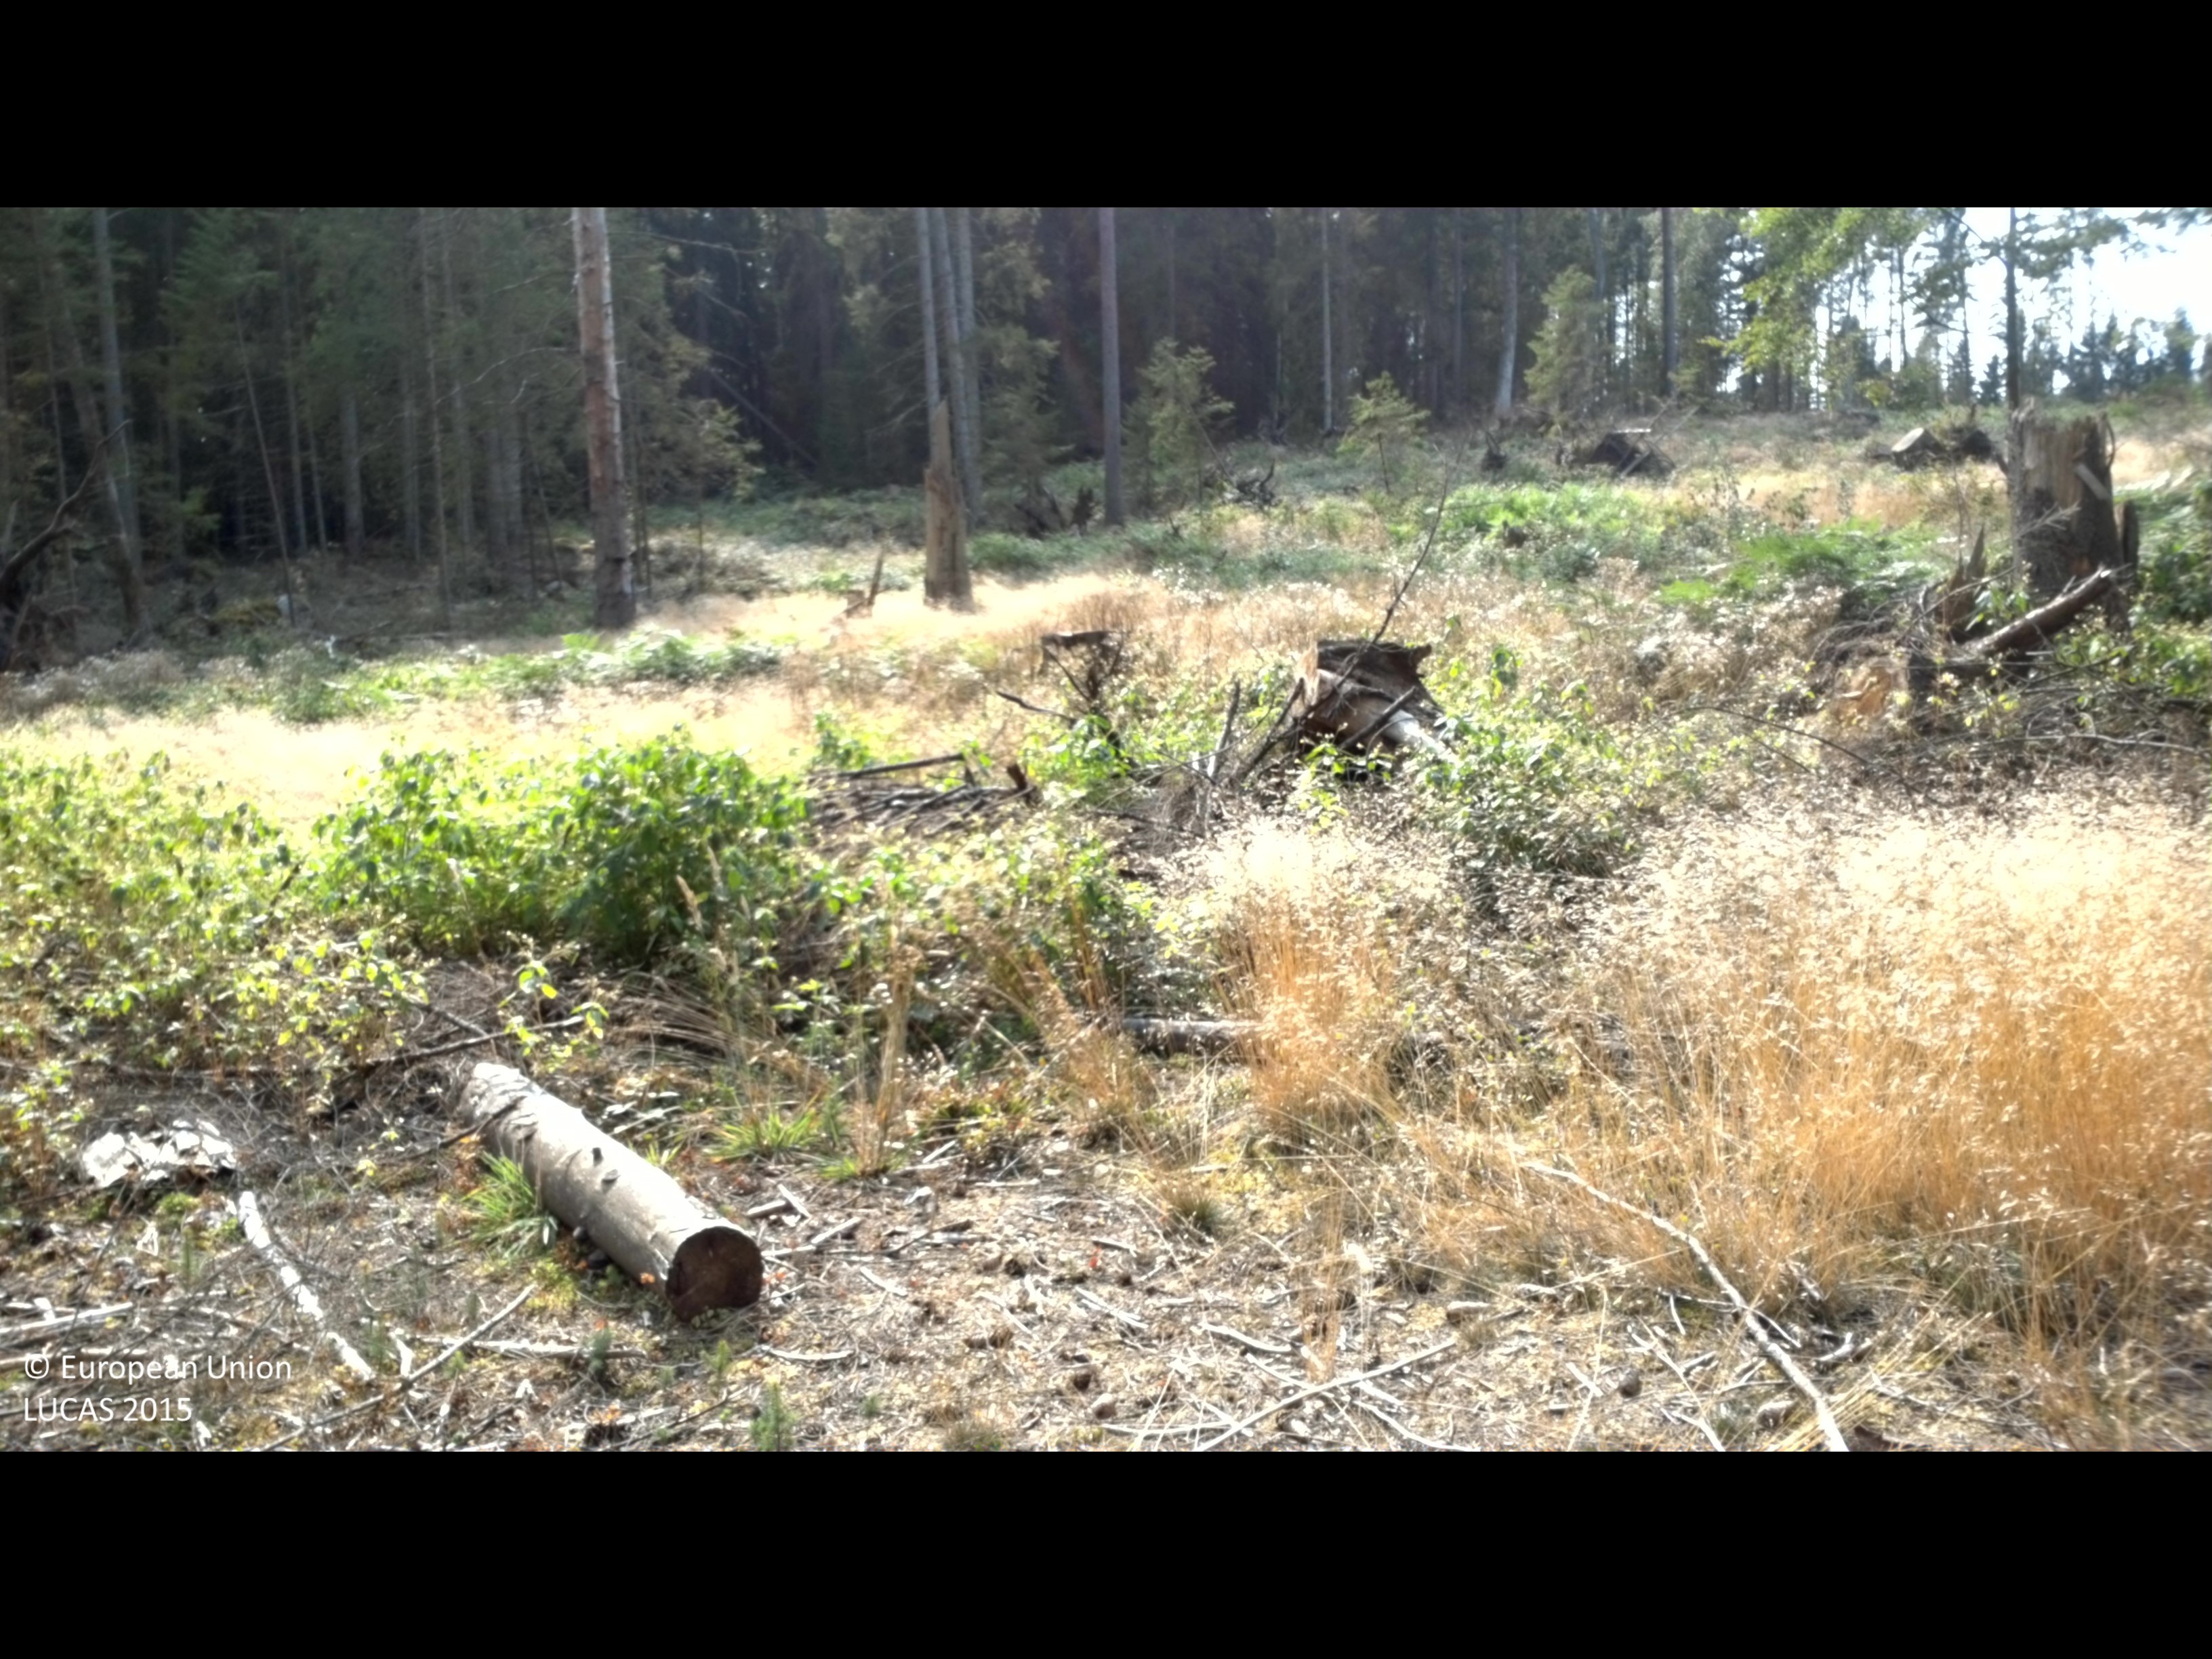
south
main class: Woodland
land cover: Spruce dominated coniferous woodland
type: boreal forest
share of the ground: 25 - 50 %
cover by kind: coniferous forest trees 35 %, herbaceous plants 25 %, shrubs 15 %, lichens and mosses 15 %, consolidated bare surface 5 %
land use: Forestry
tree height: > 5 m
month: August
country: SE
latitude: 56.2838
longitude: 14.1166
